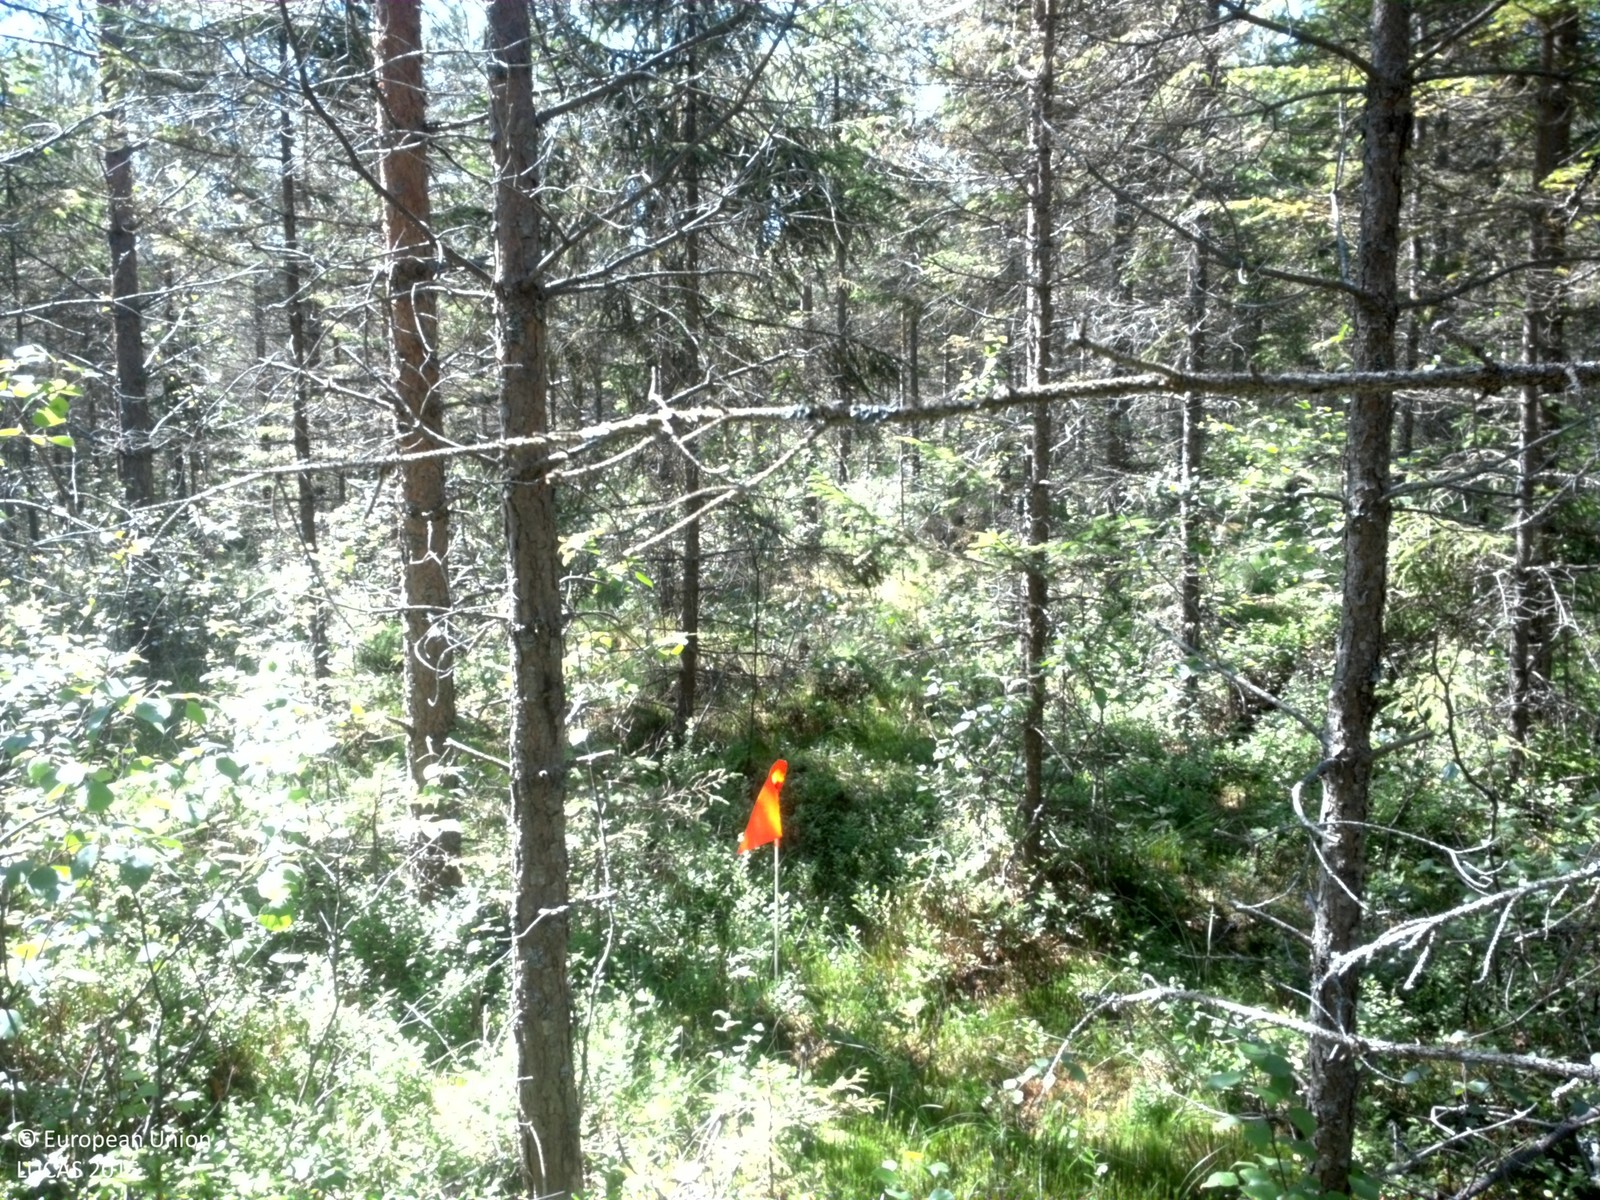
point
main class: Woodland
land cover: Other coniferous woodland
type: boreal forest
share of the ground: 50 - 75 %
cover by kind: coniferous forest trees 60 %, broadleaved forest trees 10 %, shrubs 10 %, herbaceous plants 10 %, lichens and mosses 10 %
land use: Forestry
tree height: > 5 m
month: July
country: SE
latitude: 59.6327
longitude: 14.7255
